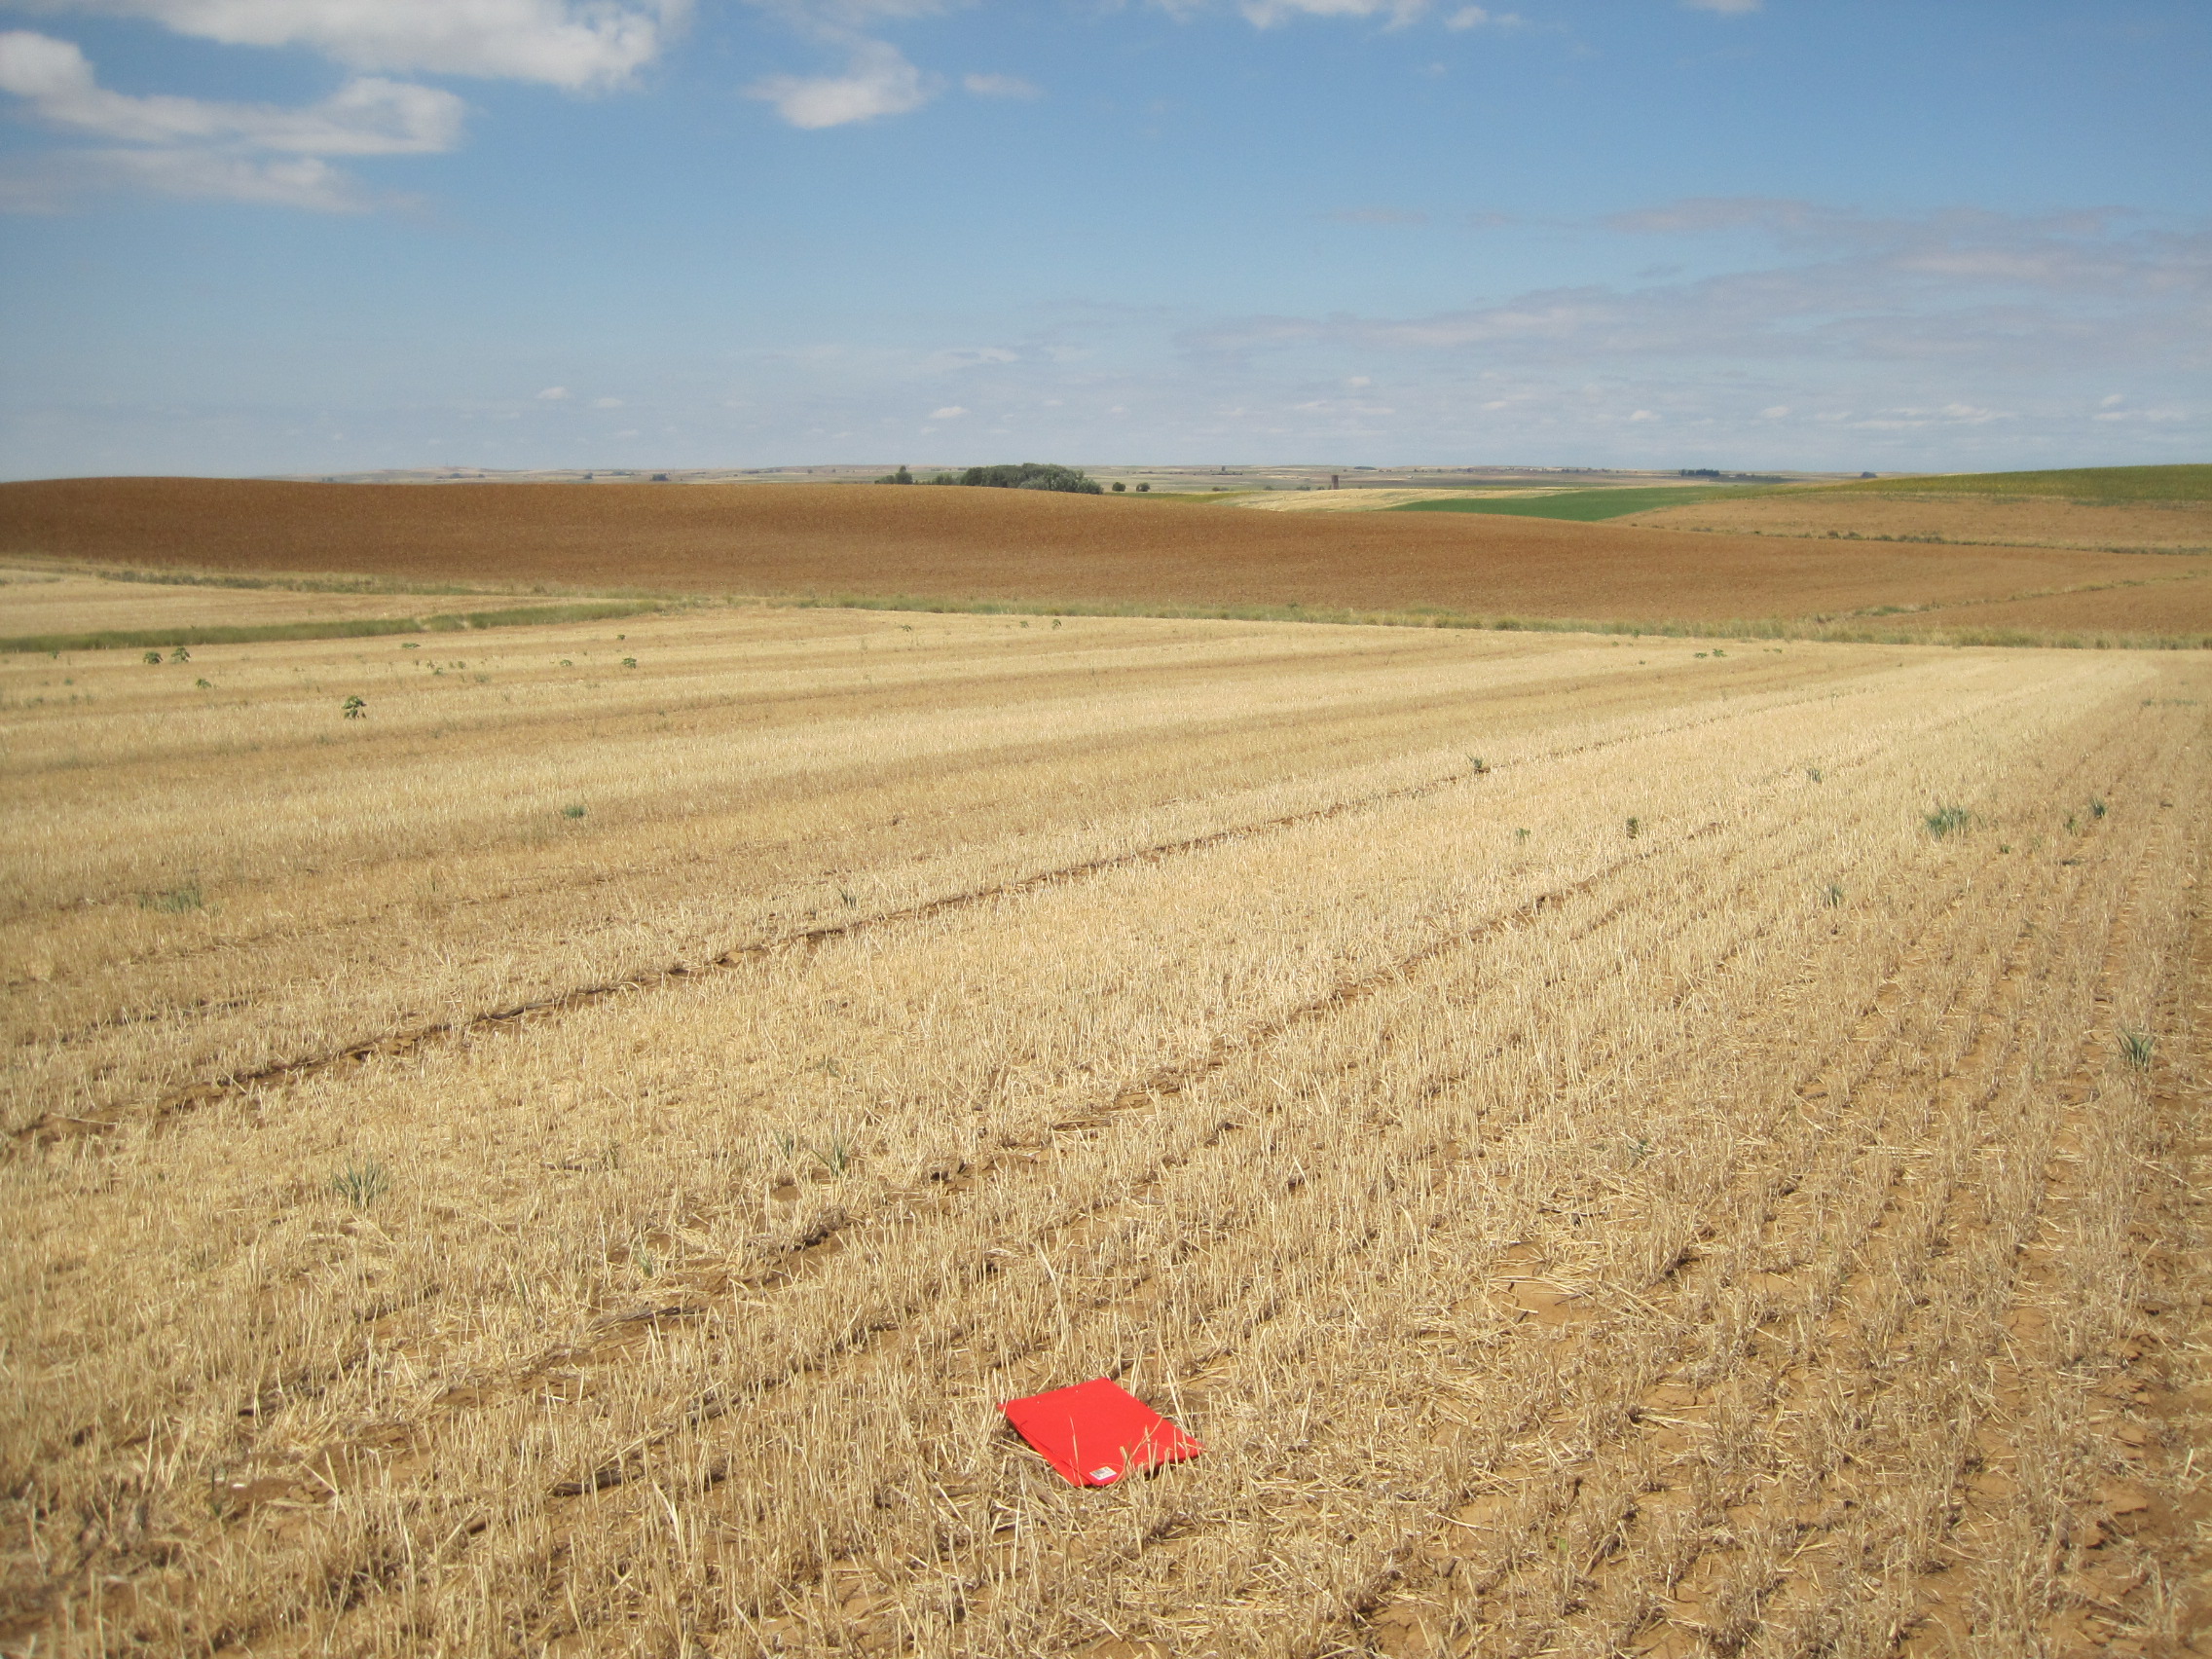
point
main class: Cropland
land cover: Barley
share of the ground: < 10 %
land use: Agriculture (excluding fallow land and kitchen gardens)
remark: Harvested field
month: July
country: ES
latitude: 42.0498
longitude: -5.1977
